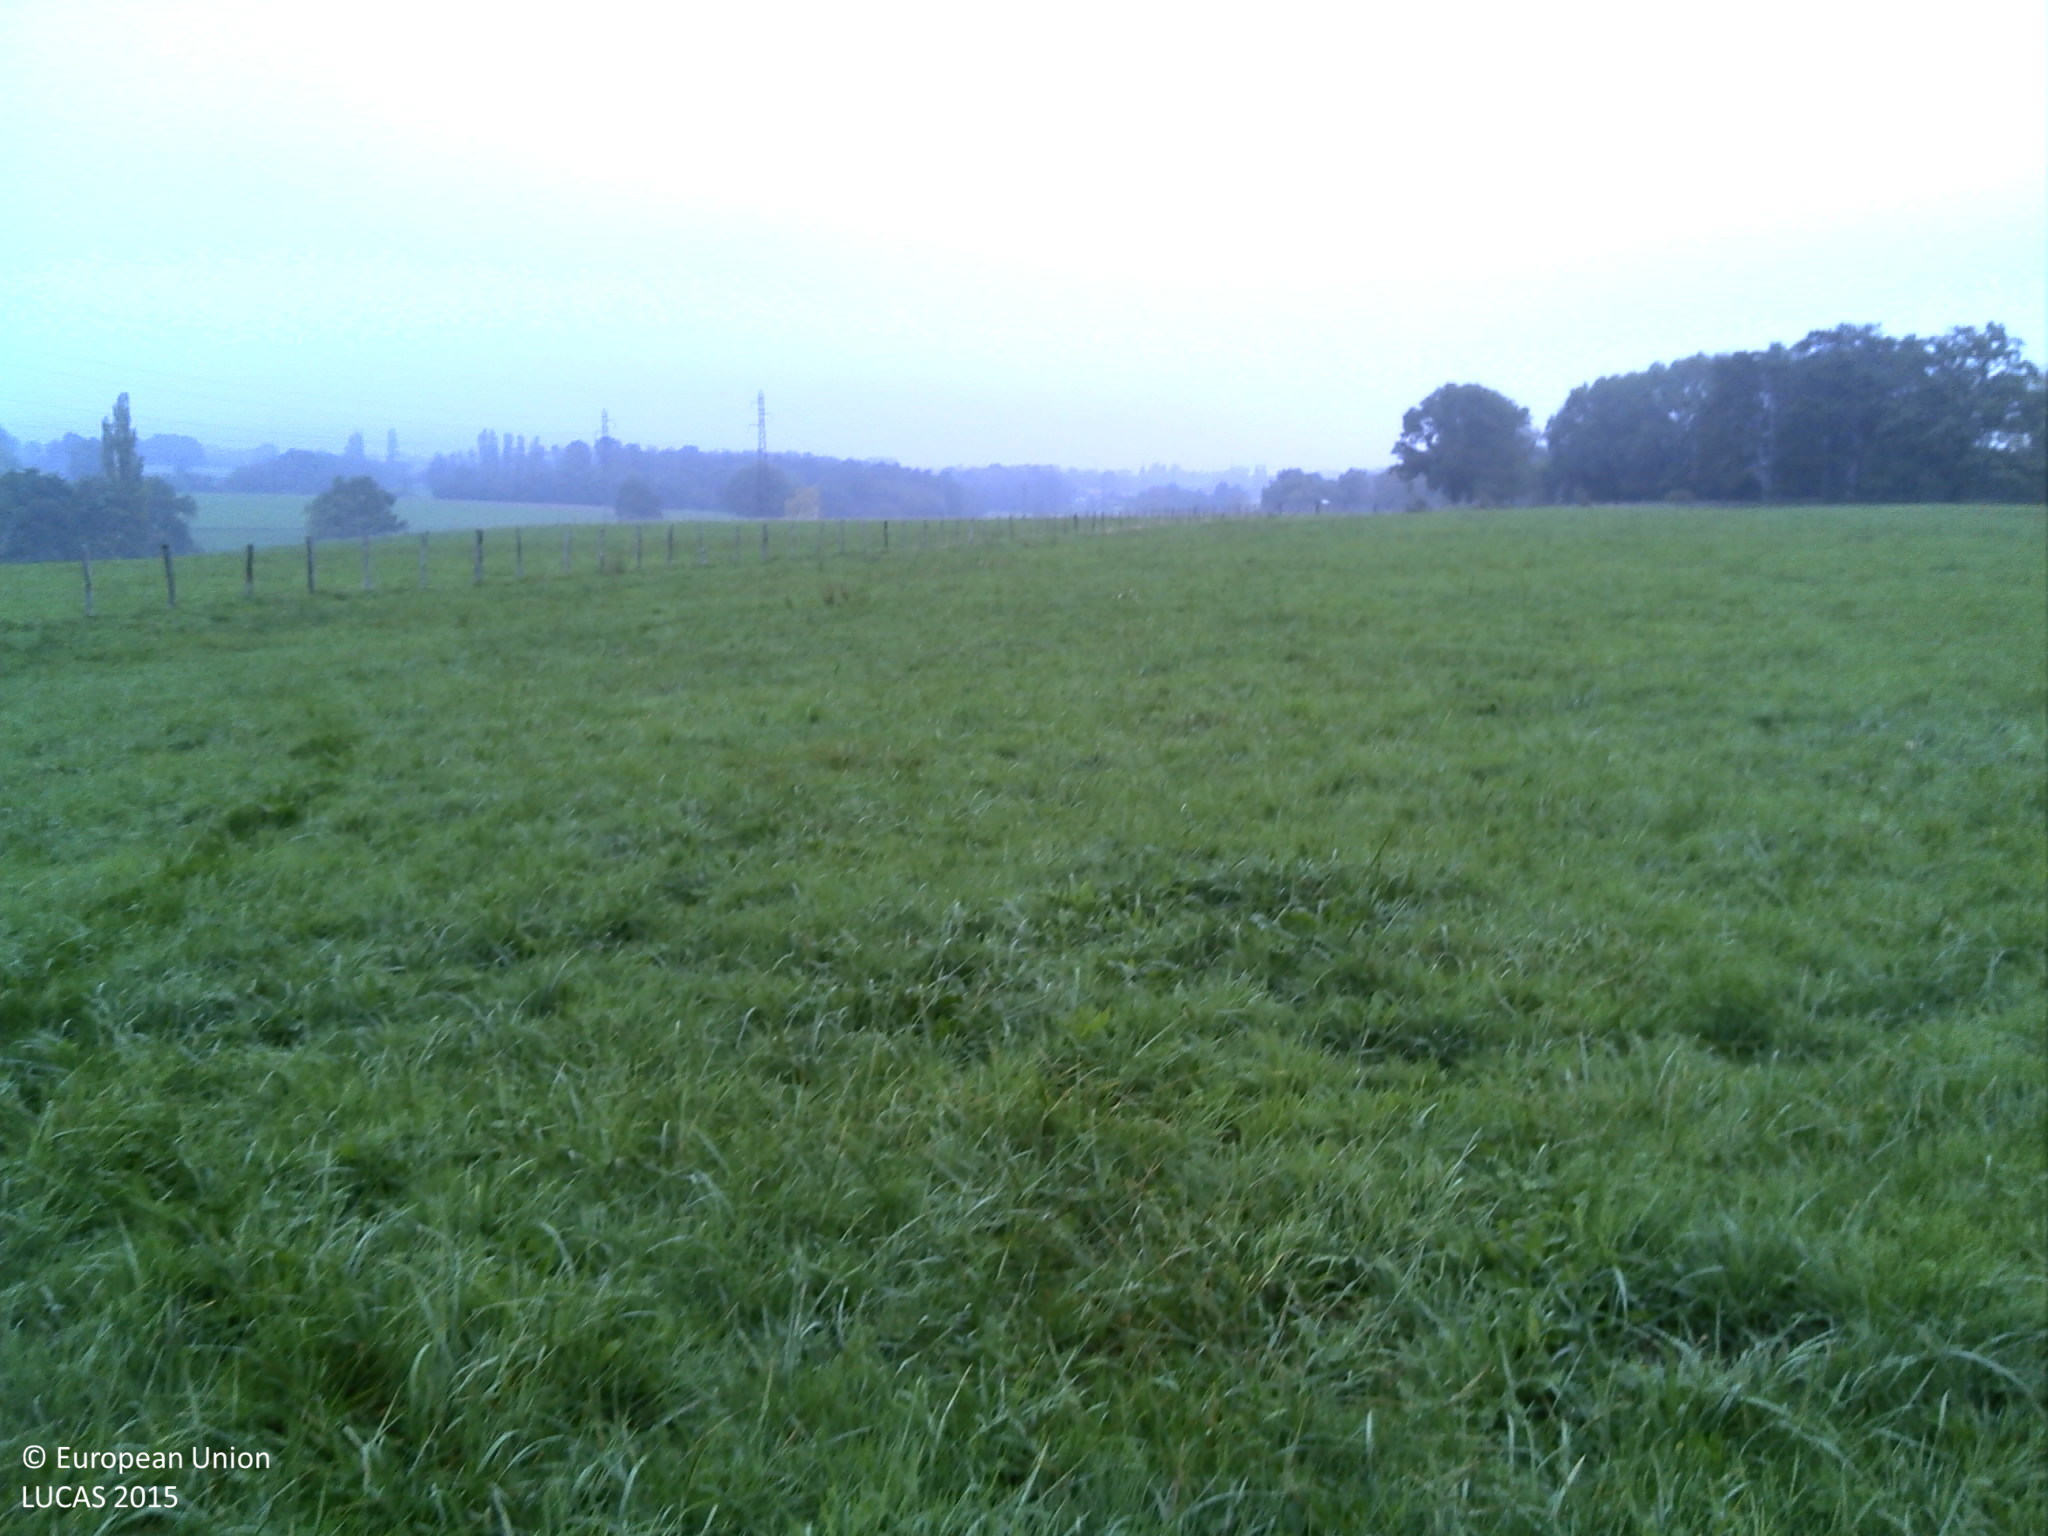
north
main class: Grassland
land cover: Grassland without tree/shrub cover
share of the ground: > 75 %
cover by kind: herbaceous plants 100 %
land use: Agriculture (excluding fallow land and kitchen gardens)
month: October
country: FR
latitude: 46.4263
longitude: 4.8621
